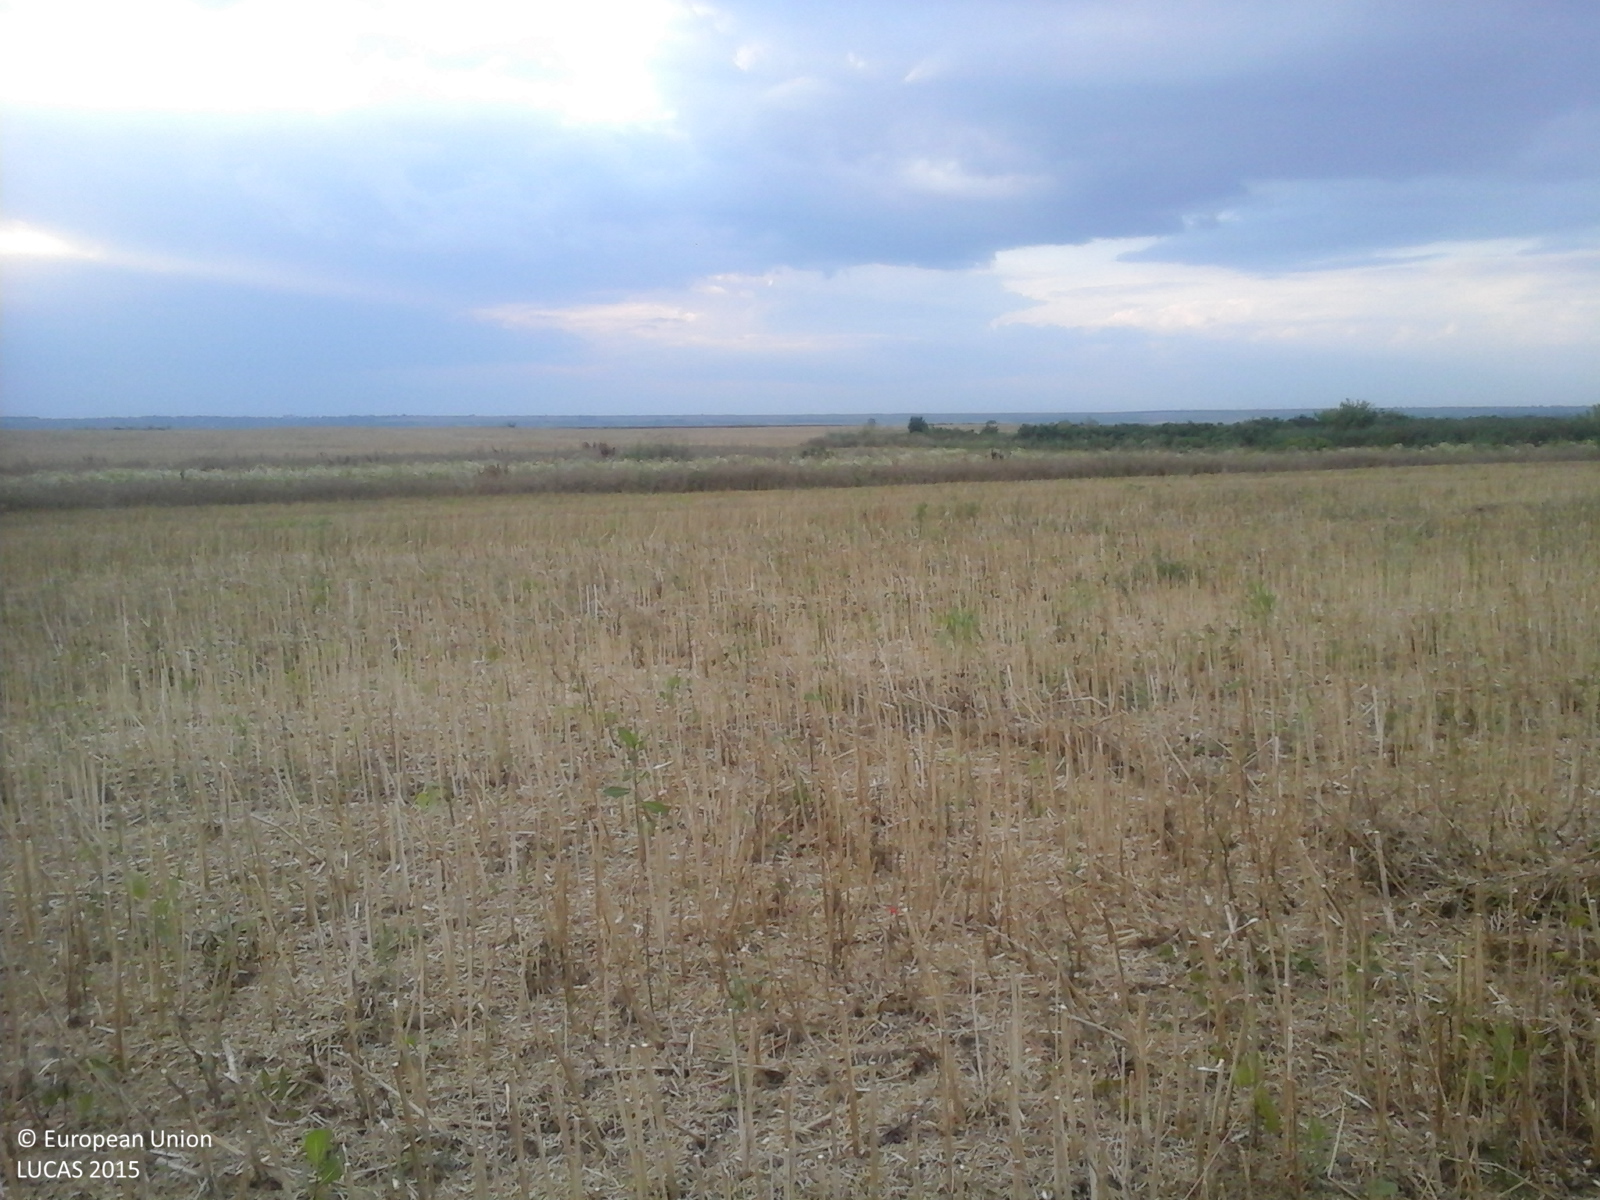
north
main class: Cropland
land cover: Rape and turnip rape
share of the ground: < 10 %
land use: Agriculture (excluding fallow land and kitchen gardens)
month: June
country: RO
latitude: 44.0112
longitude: 26.1550
